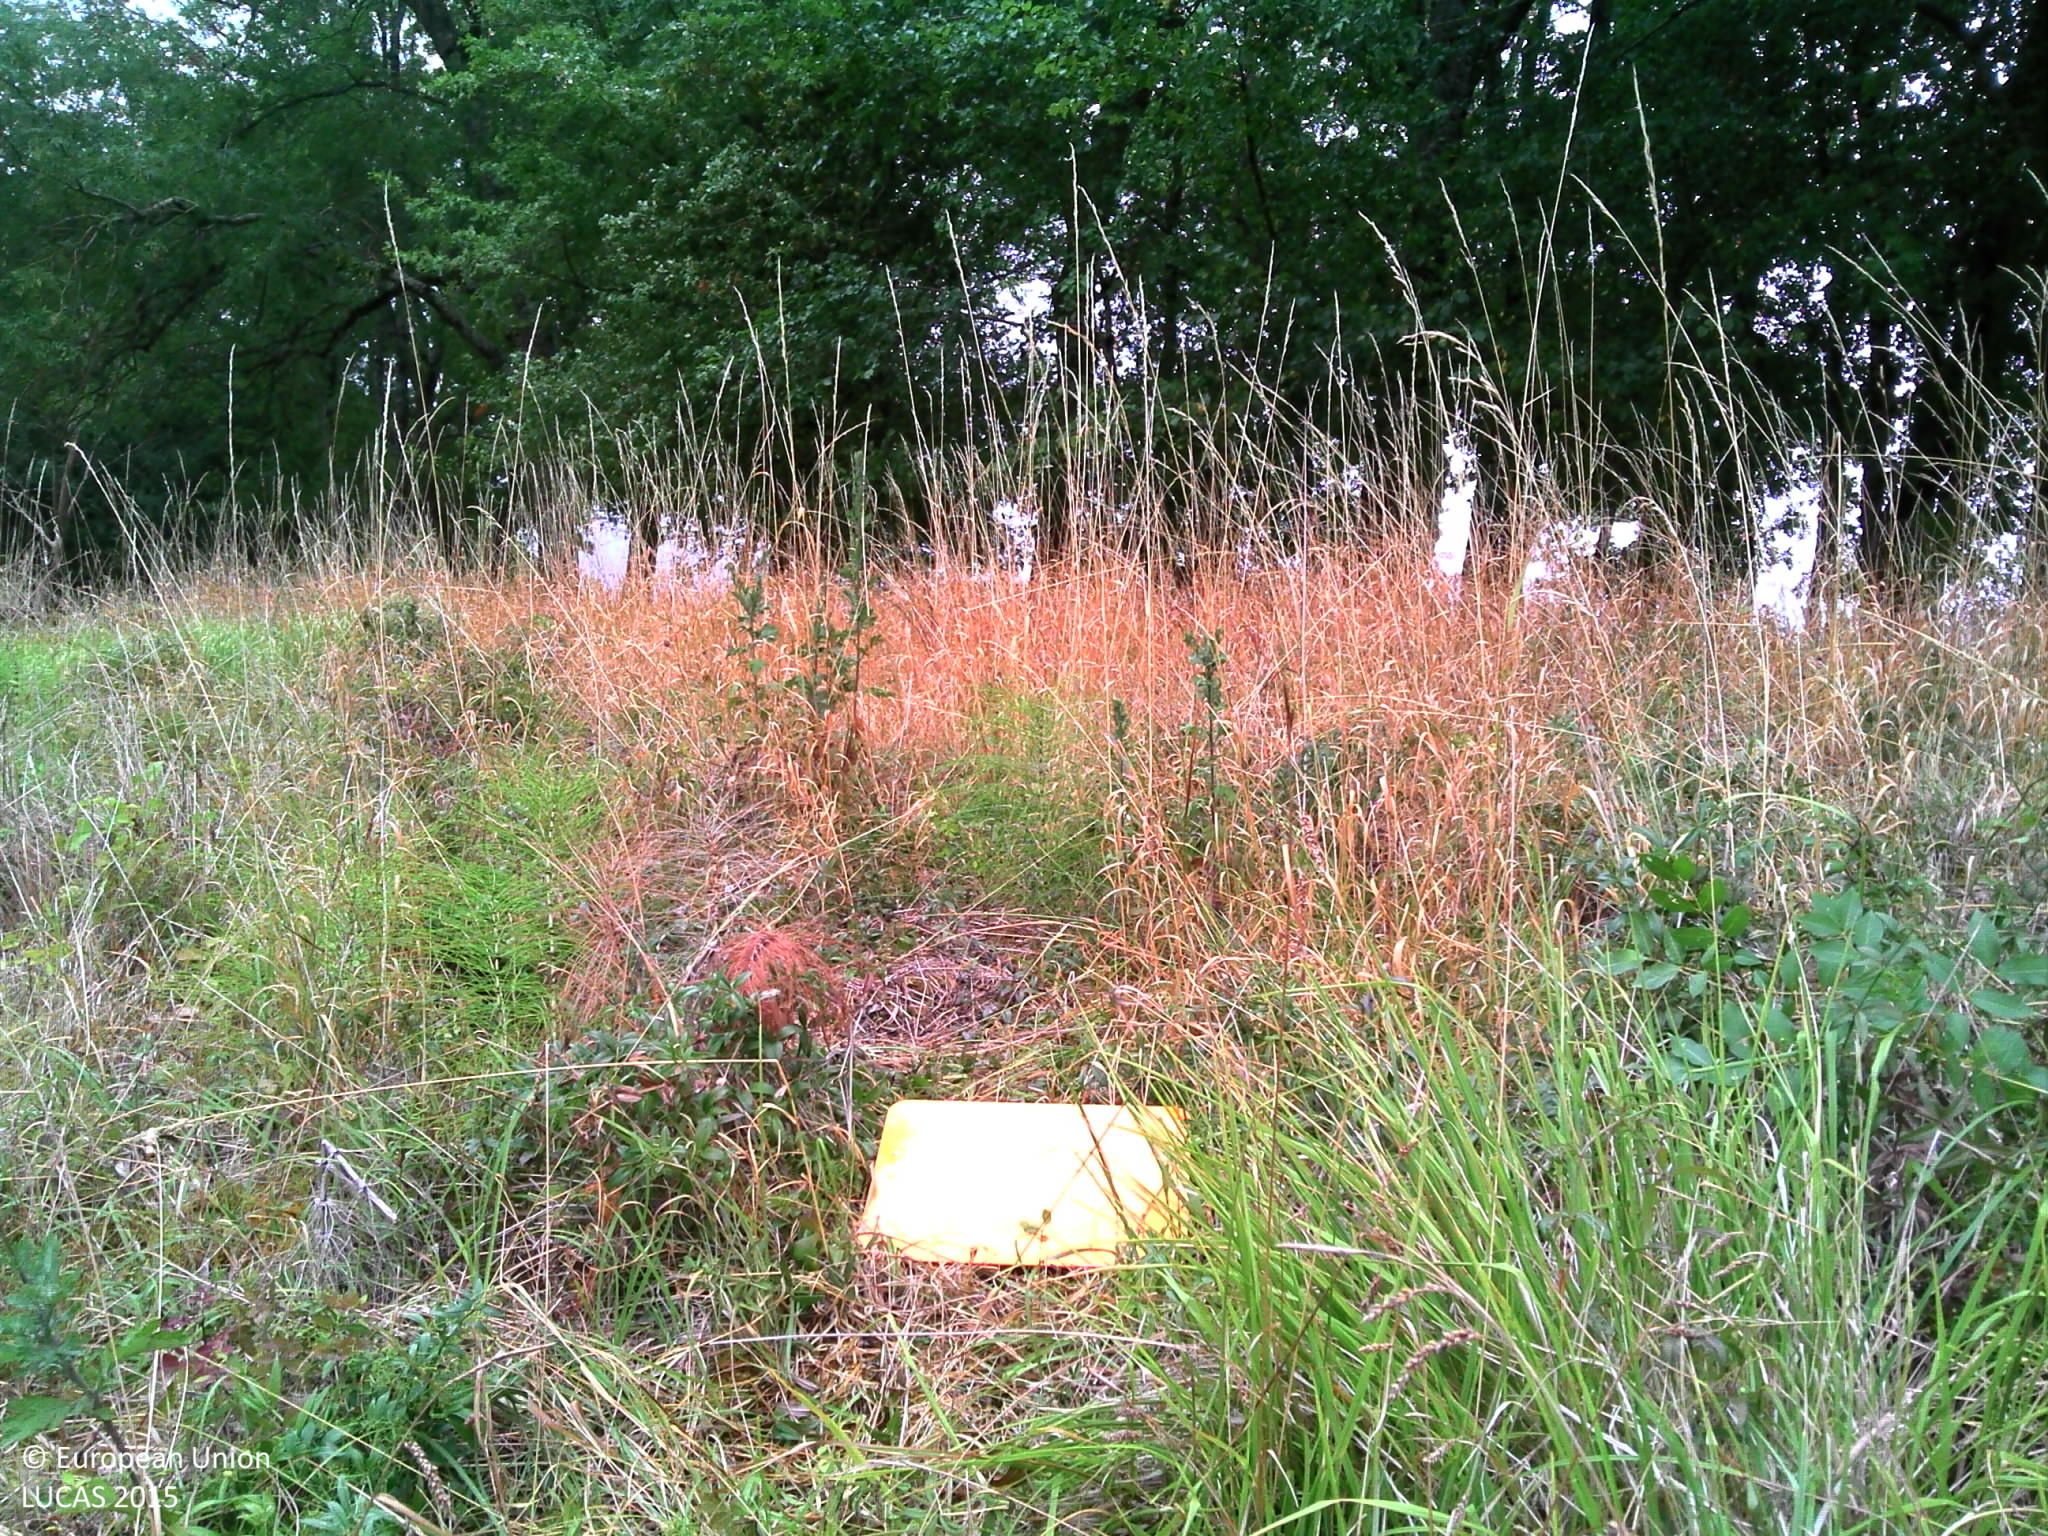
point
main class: Woodland
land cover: Broadleaved woodland
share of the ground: > 75 %
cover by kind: broadleaved forest trees 75 %, herbaceous plants 20 %, shrubs 5 %
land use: Semi-natural and natural areas not in use
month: August
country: FR
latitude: 44.2487
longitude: 0.5892
